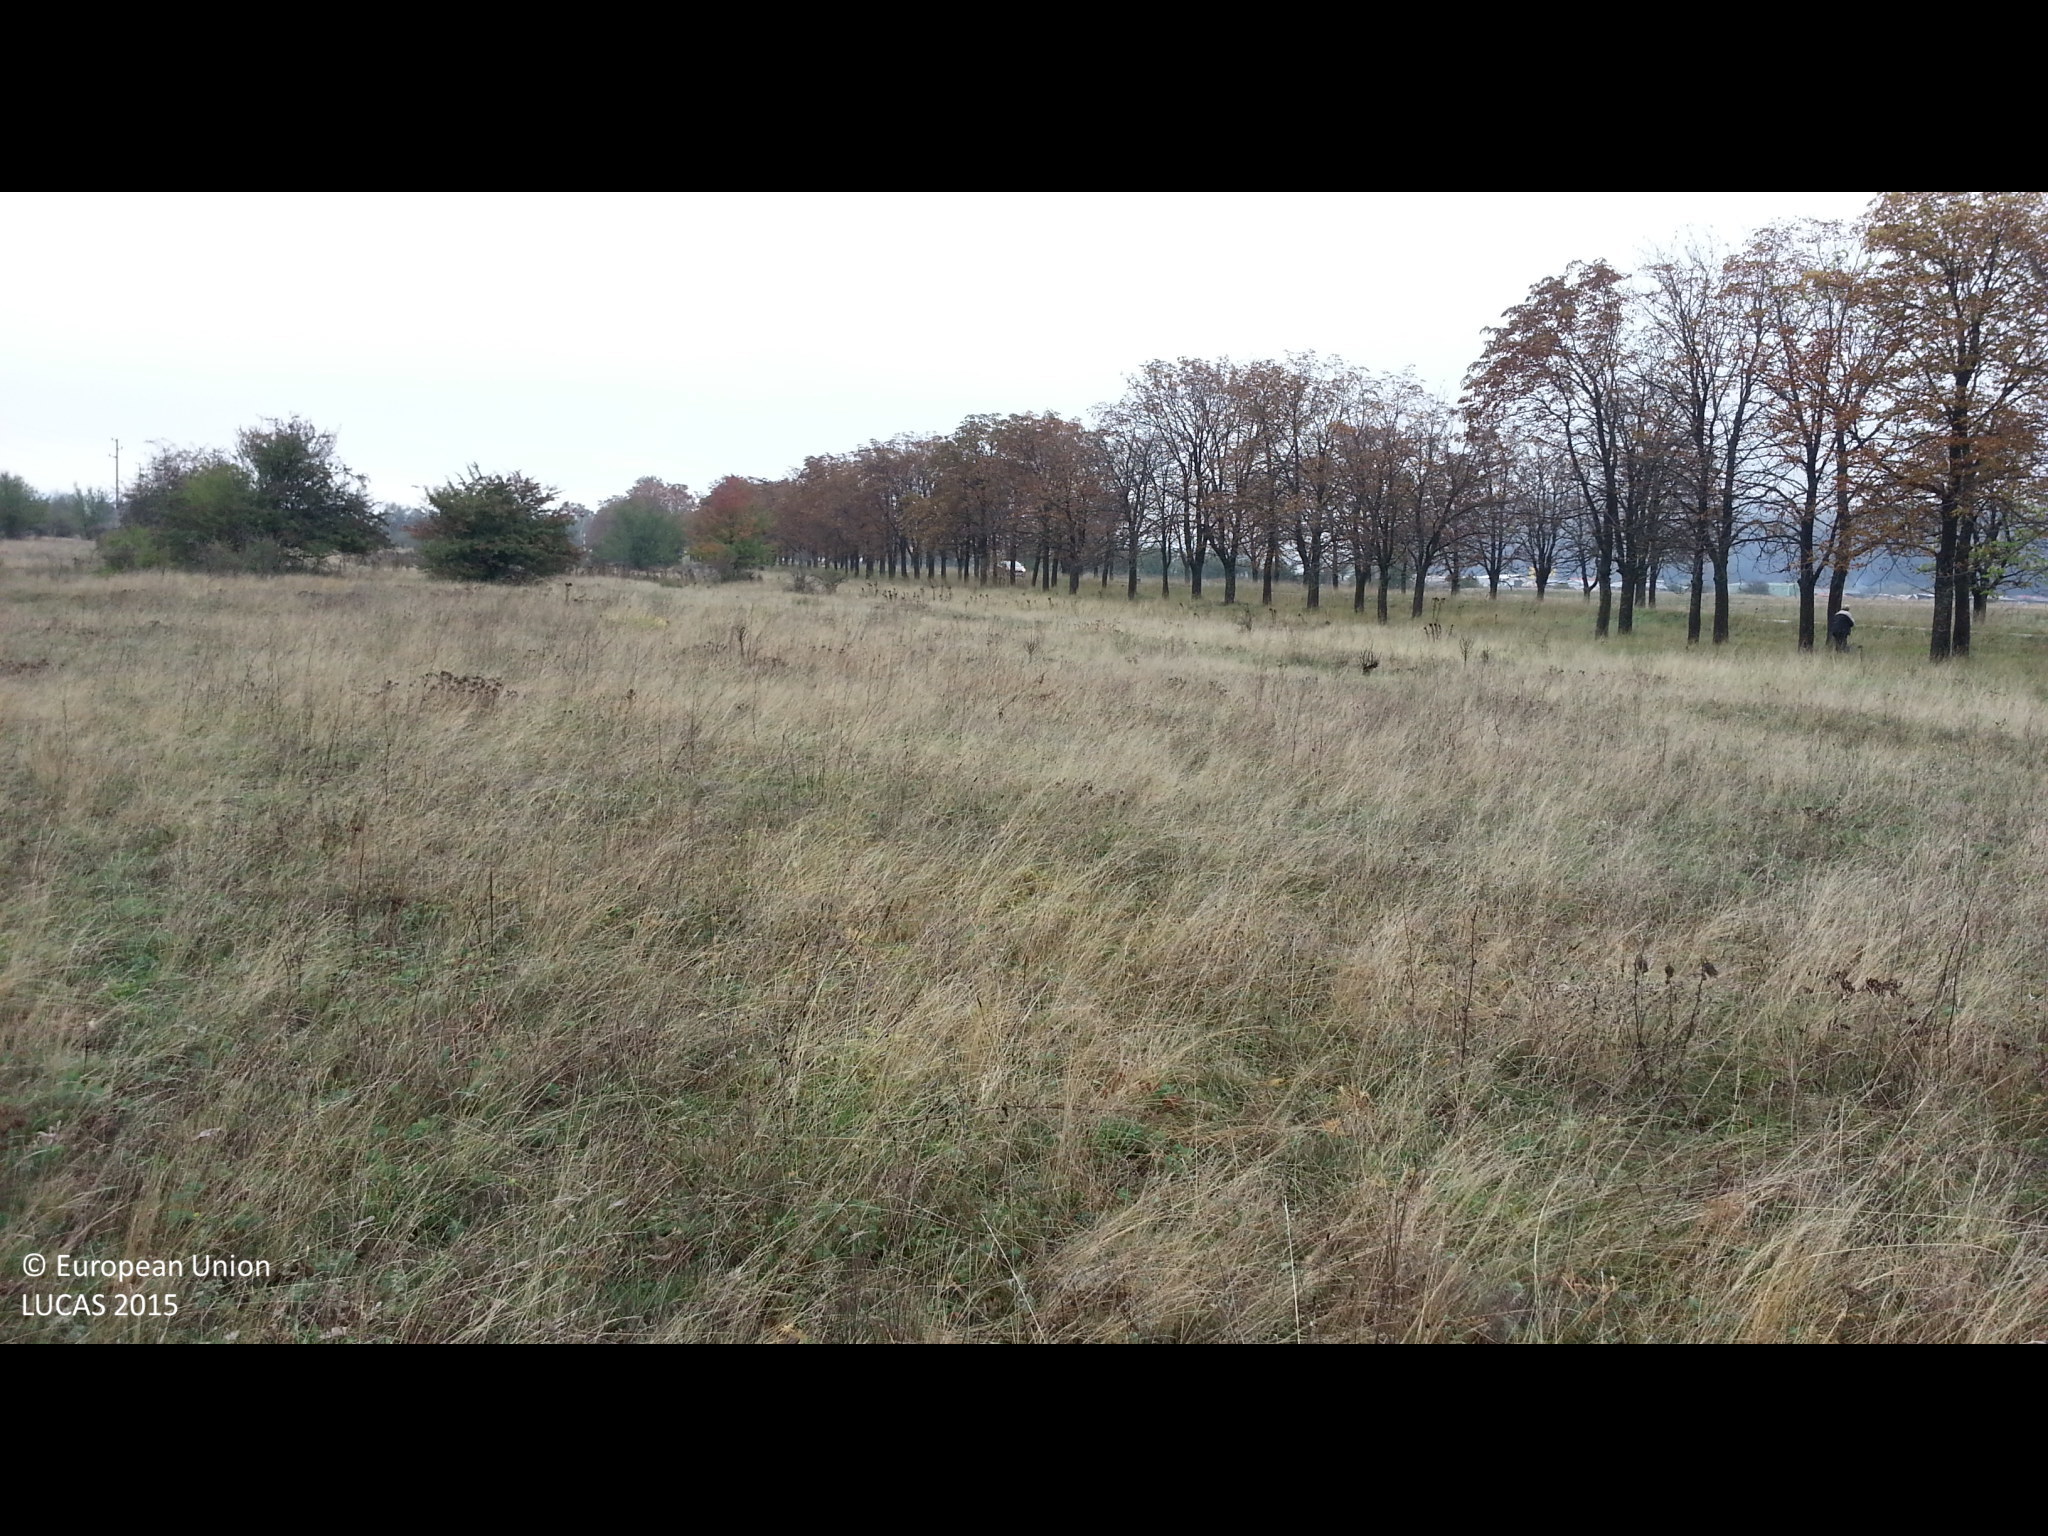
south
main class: Grassland
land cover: Grassland without tree/shrub cover
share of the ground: > 75 %
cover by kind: herbaceous plants 100 %
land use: Agriculture (excluding fallow land and kitchen gardens)
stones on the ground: < 10 %
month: October
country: BG
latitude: 42.3608
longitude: 23.5478
